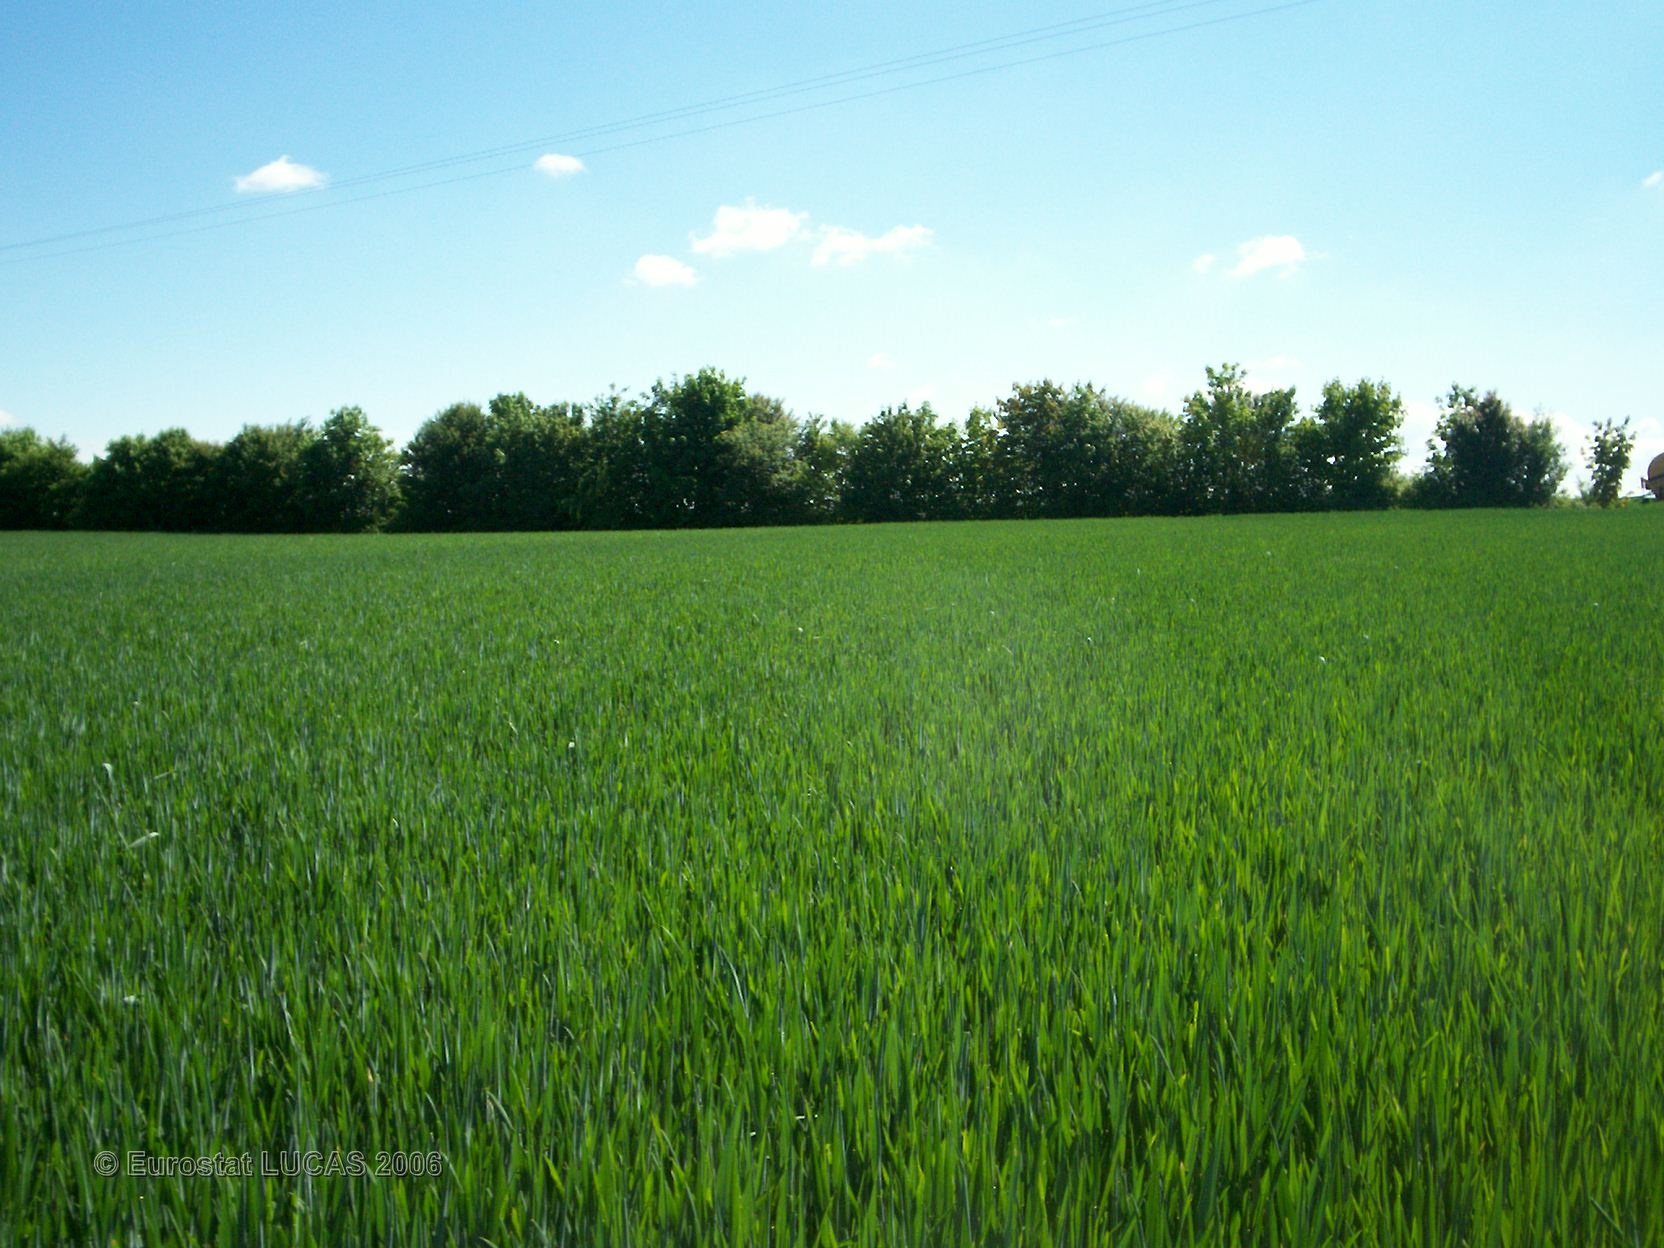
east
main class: Cropland
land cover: Common wheat
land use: Agriculture (excluding fallow land and kitchen gardens)
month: May
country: FR
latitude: 46.5452
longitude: -0.9996
